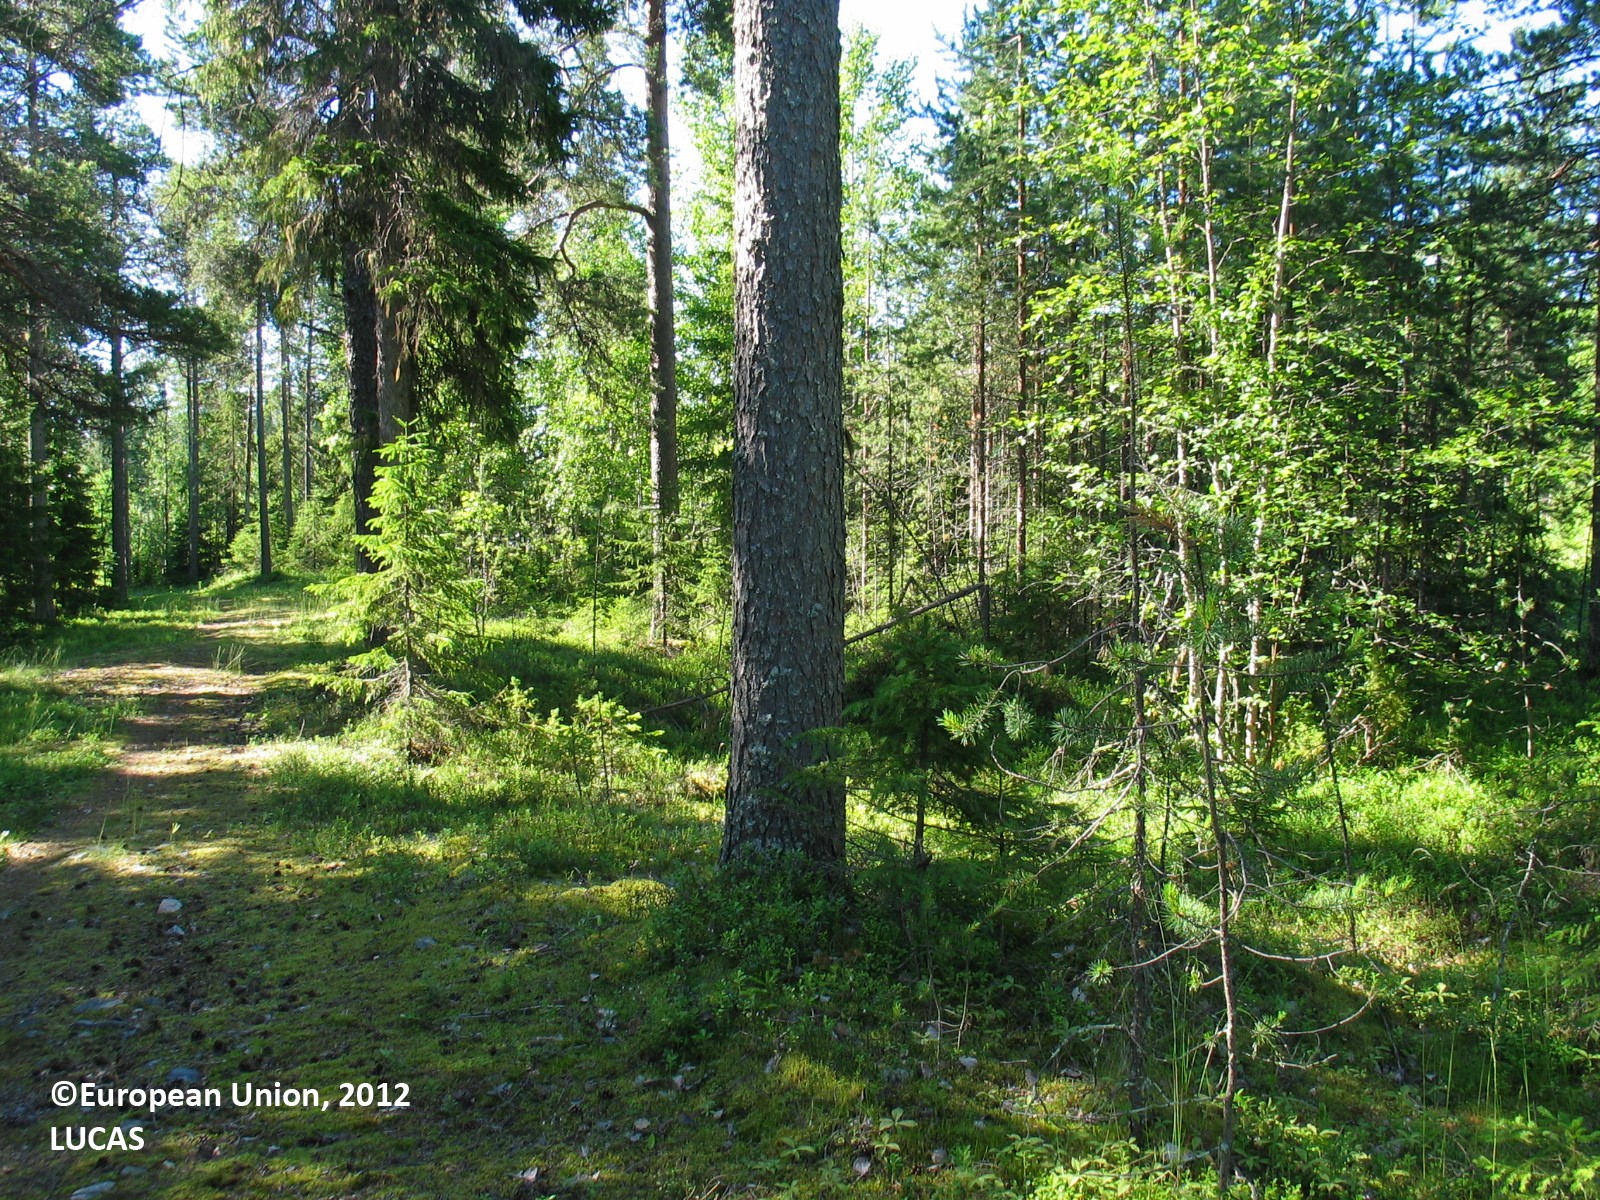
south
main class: Woodland
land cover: Other mixed woodland
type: boreal forest
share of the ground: 50 - 75 %
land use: Forestry
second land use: Sport
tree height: > 5 m
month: July
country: FI
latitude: 65.6598
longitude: 24.9589
